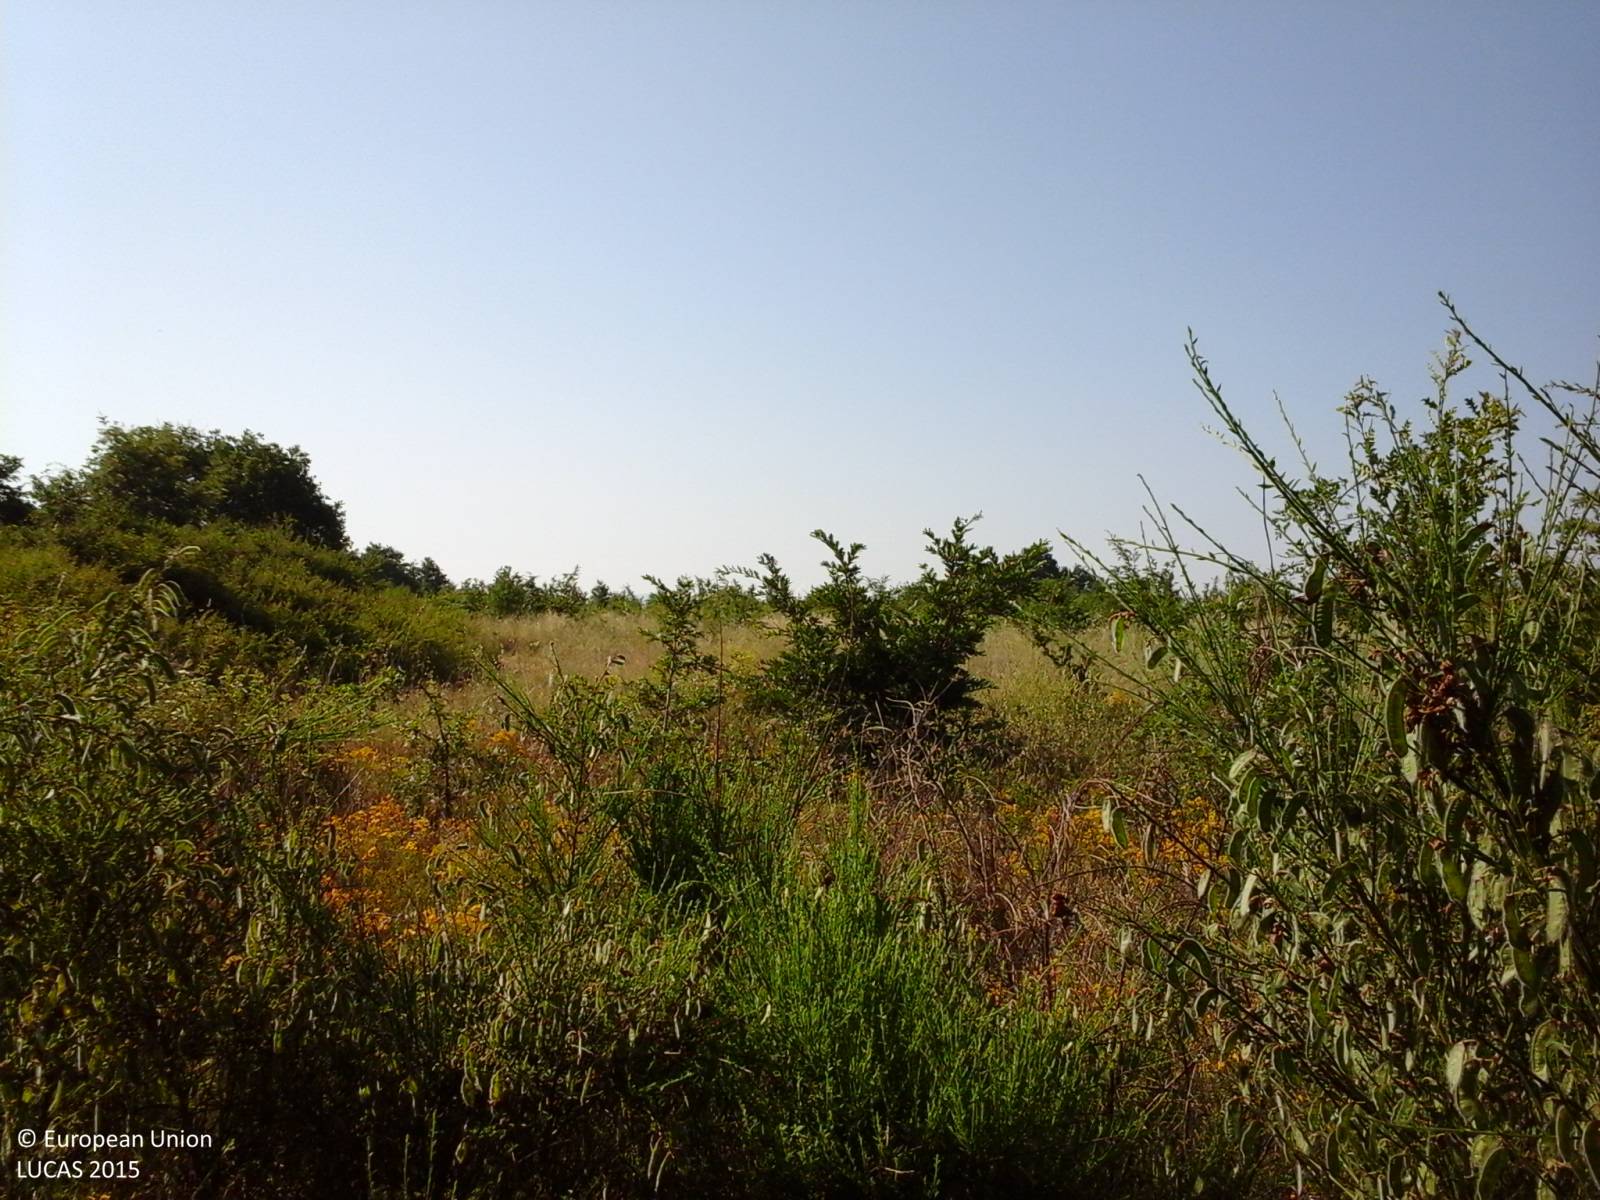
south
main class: Woodland
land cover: Broadleaved woodland
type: thermophilous deciduous forest
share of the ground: > 75 %
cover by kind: broadleaved forest trees 90 %, shrubs 10 %
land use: Forestry
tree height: > 5 m
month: June
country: IT
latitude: 42.6151
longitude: 12.0535
